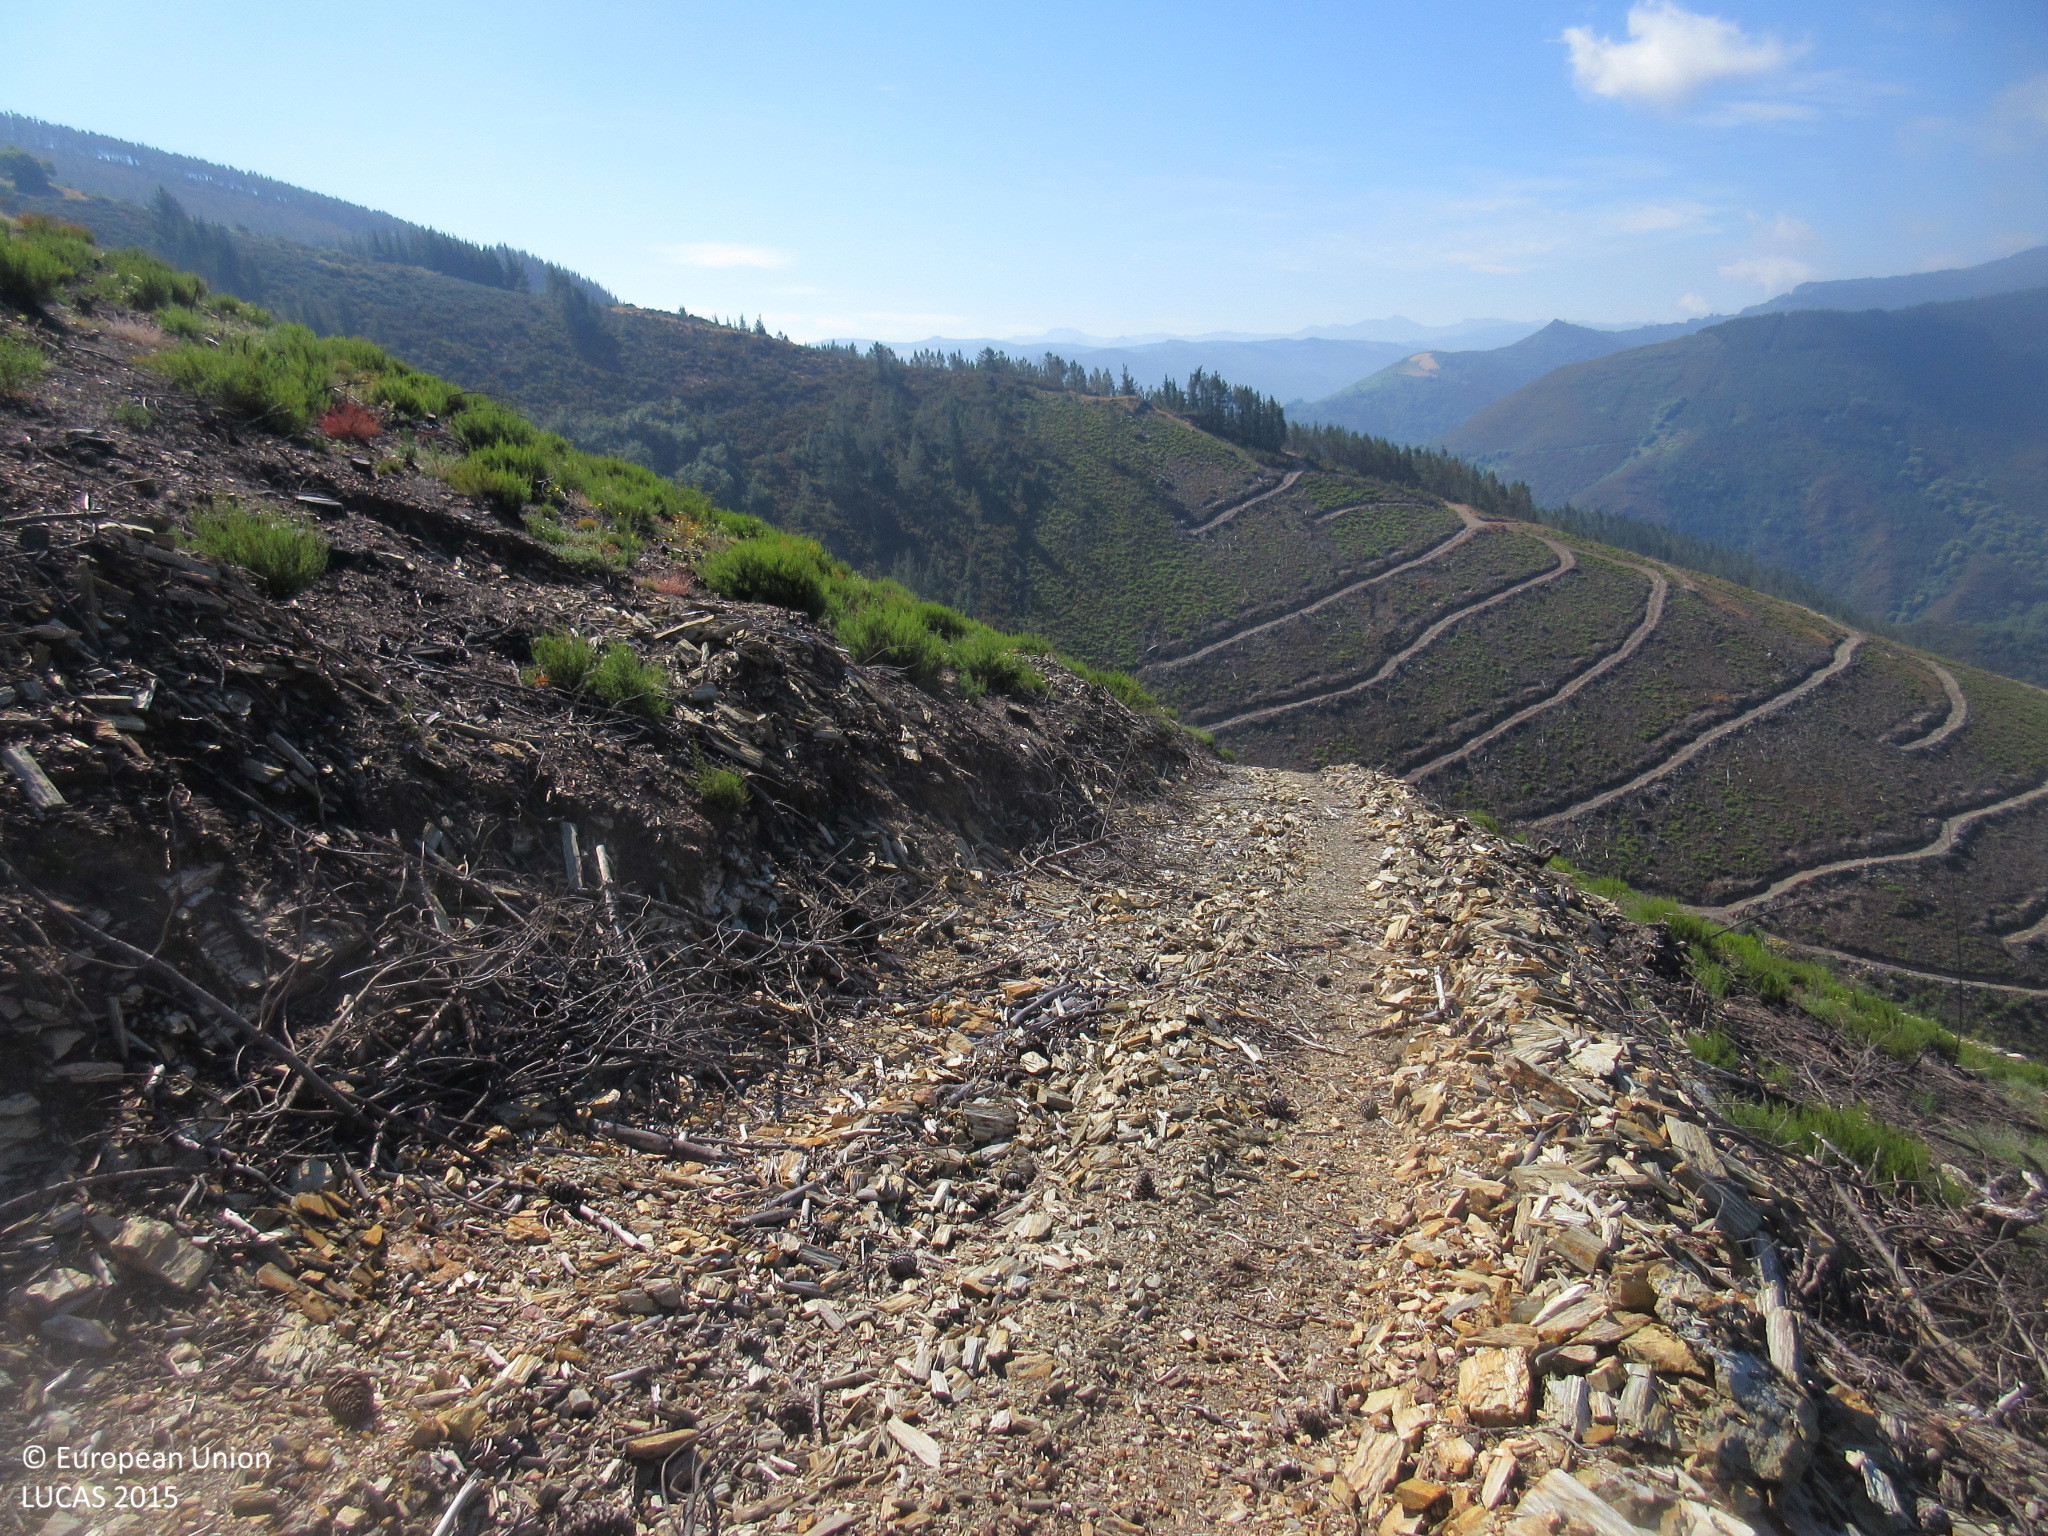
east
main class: Shrubland
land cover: Shrubland without tree cover
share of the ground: 50 - 75 %
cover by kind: shrubs 65 %, unconsolidated bare surface 35 %
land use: Forestry
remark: Clear cut
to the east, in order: Shrubland without tree cover; Tracks; Shrubland without tree cover
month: June
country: ES
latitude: 43.0822
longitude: -7.0015
